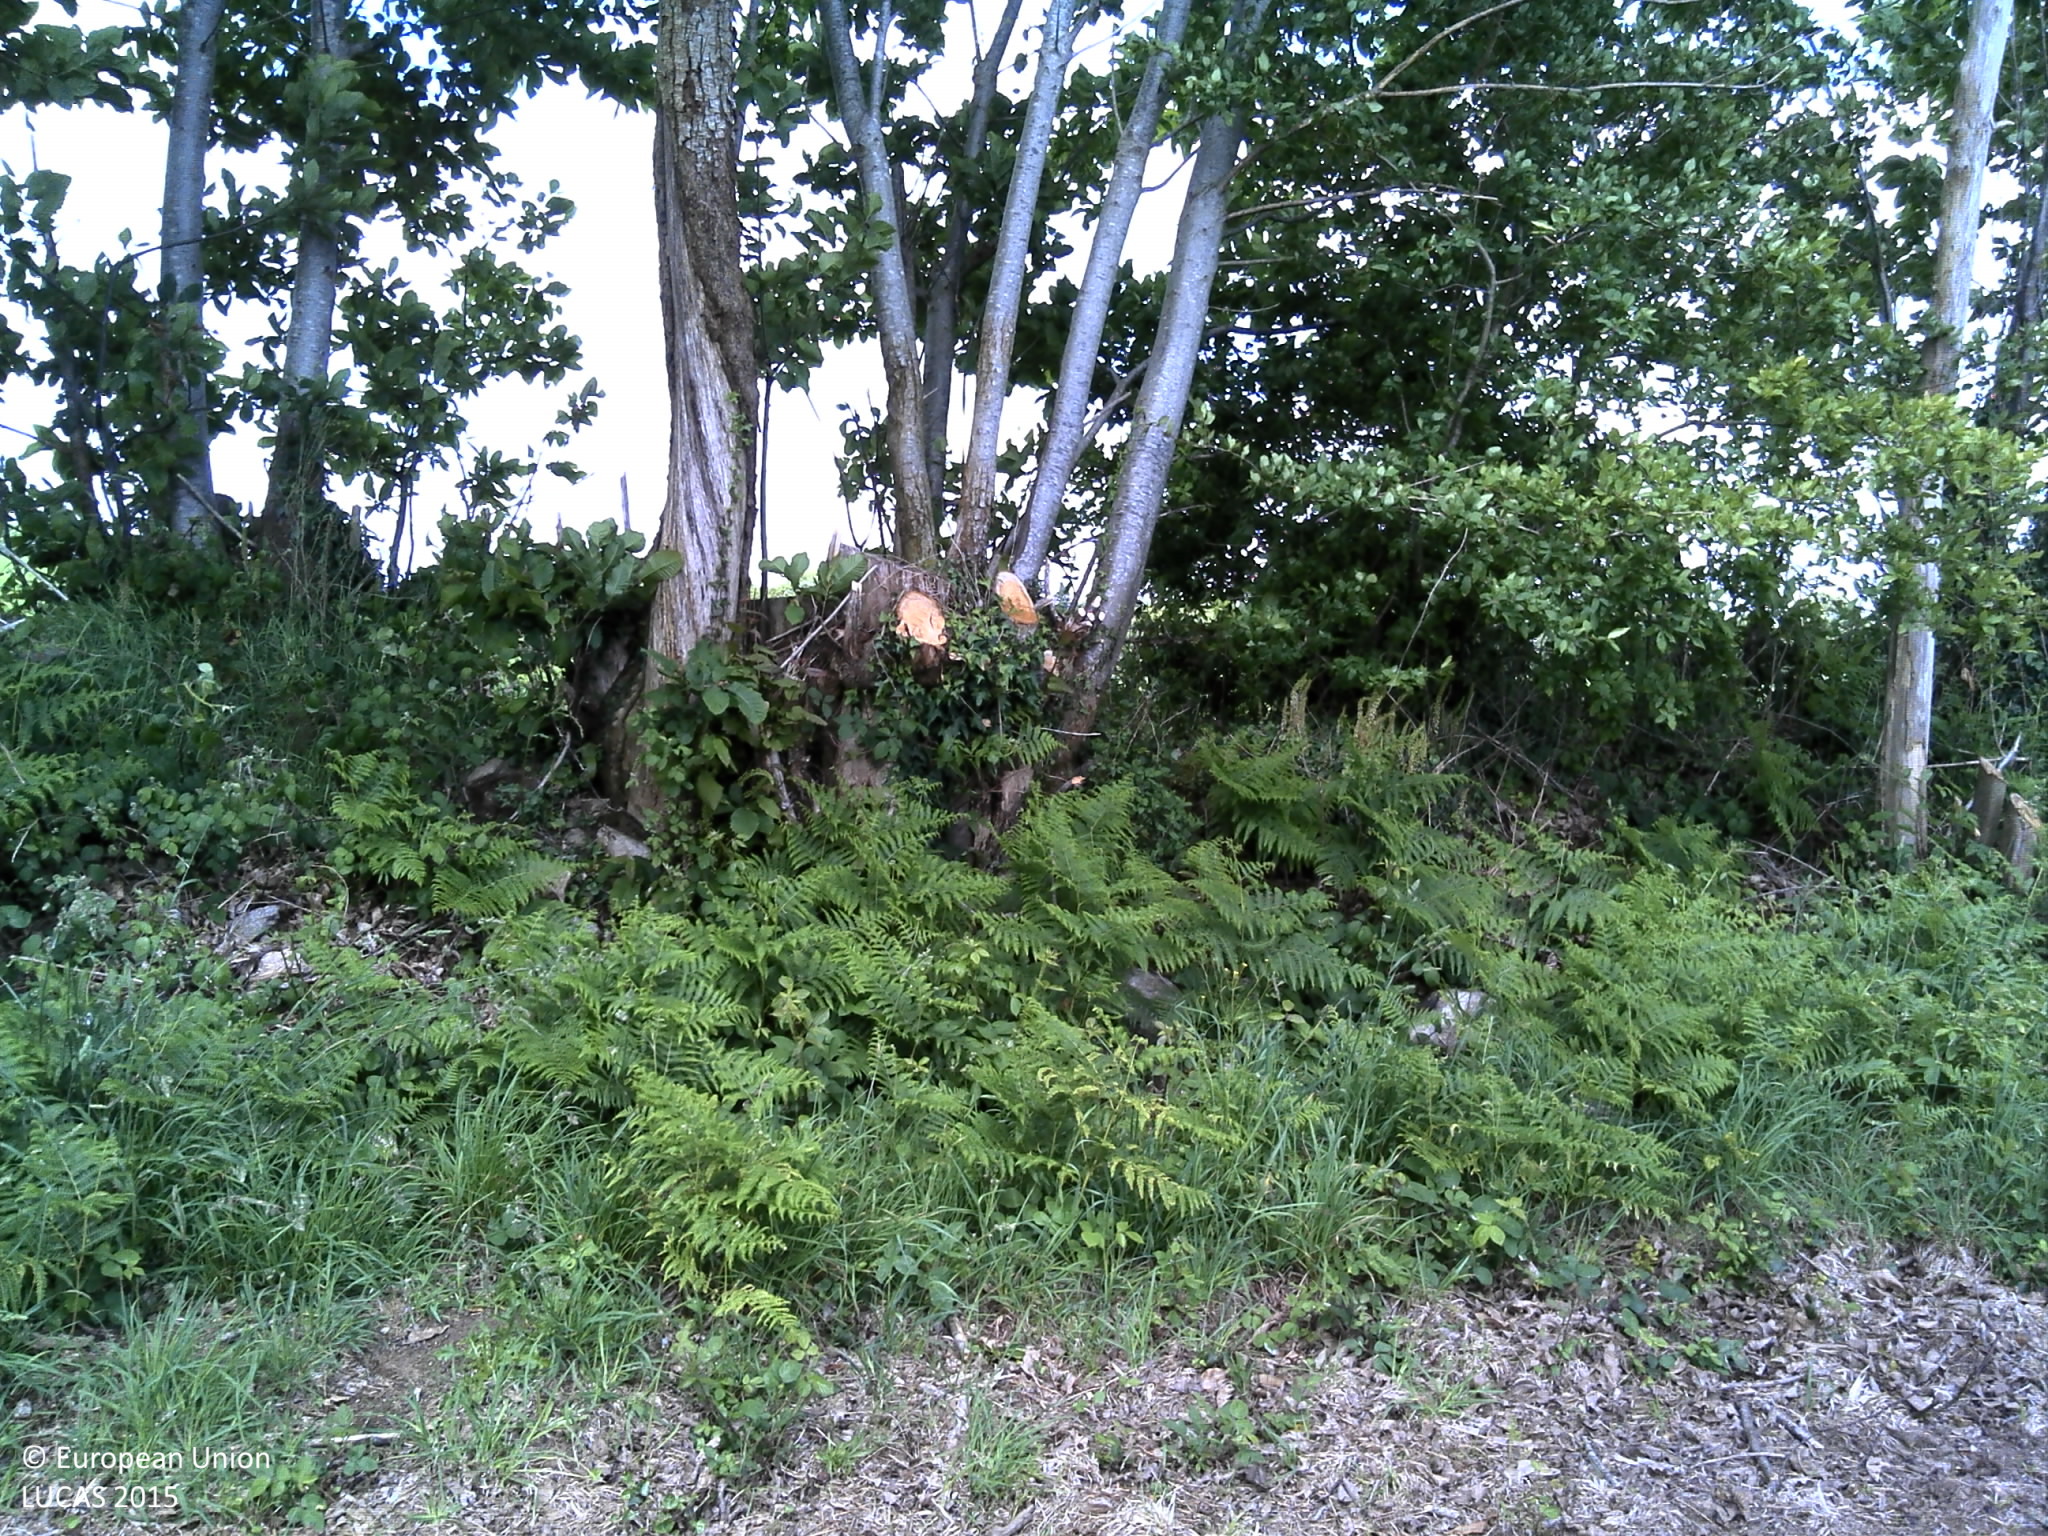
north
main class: Cropland
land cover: Maize
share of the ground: 10 - 25 %
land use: Agriculture (excluding fallow land and kitchen gardens)
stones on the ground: 10 - 25 %
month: June
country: FR
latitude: 47.9608
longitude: -3.5911
